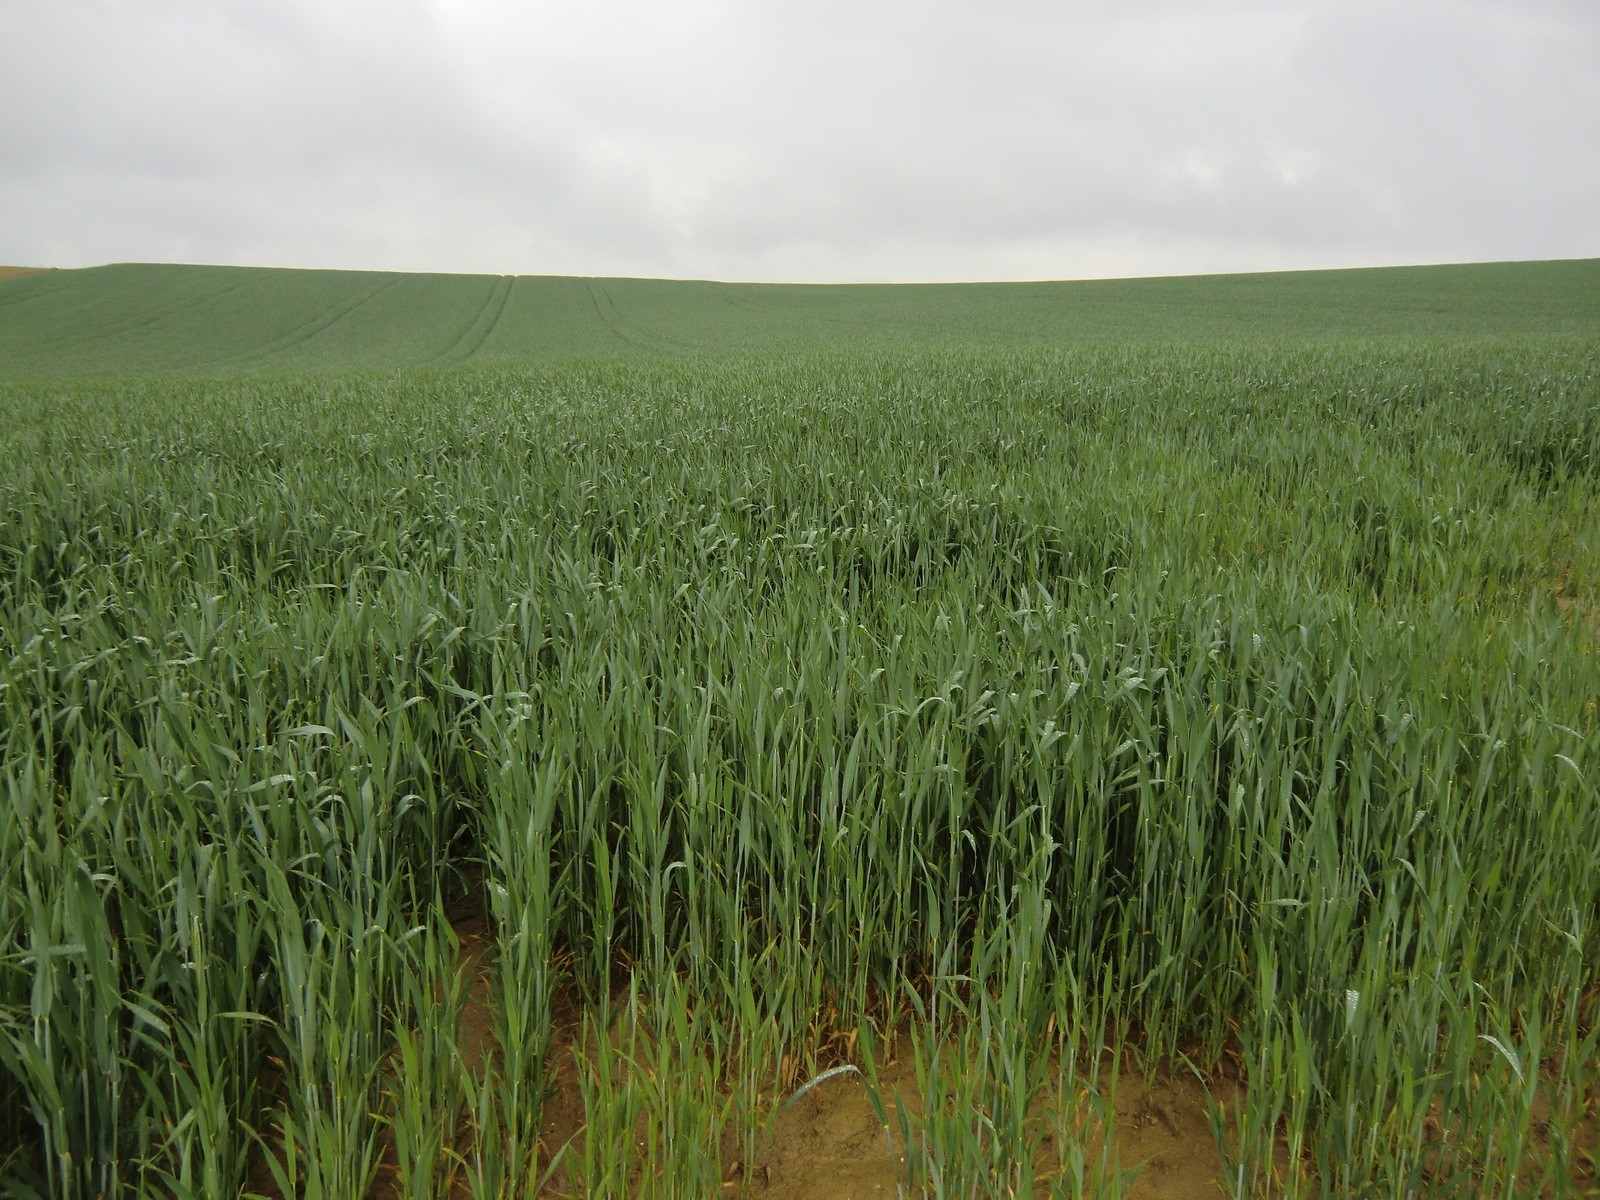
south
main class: Cropland
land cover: Common wheat
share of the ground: > 75 %
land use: Agriculture (excluding fallow land and kitchen gardens)
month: May
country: AT
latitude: 48.1138
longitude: 15.3074
